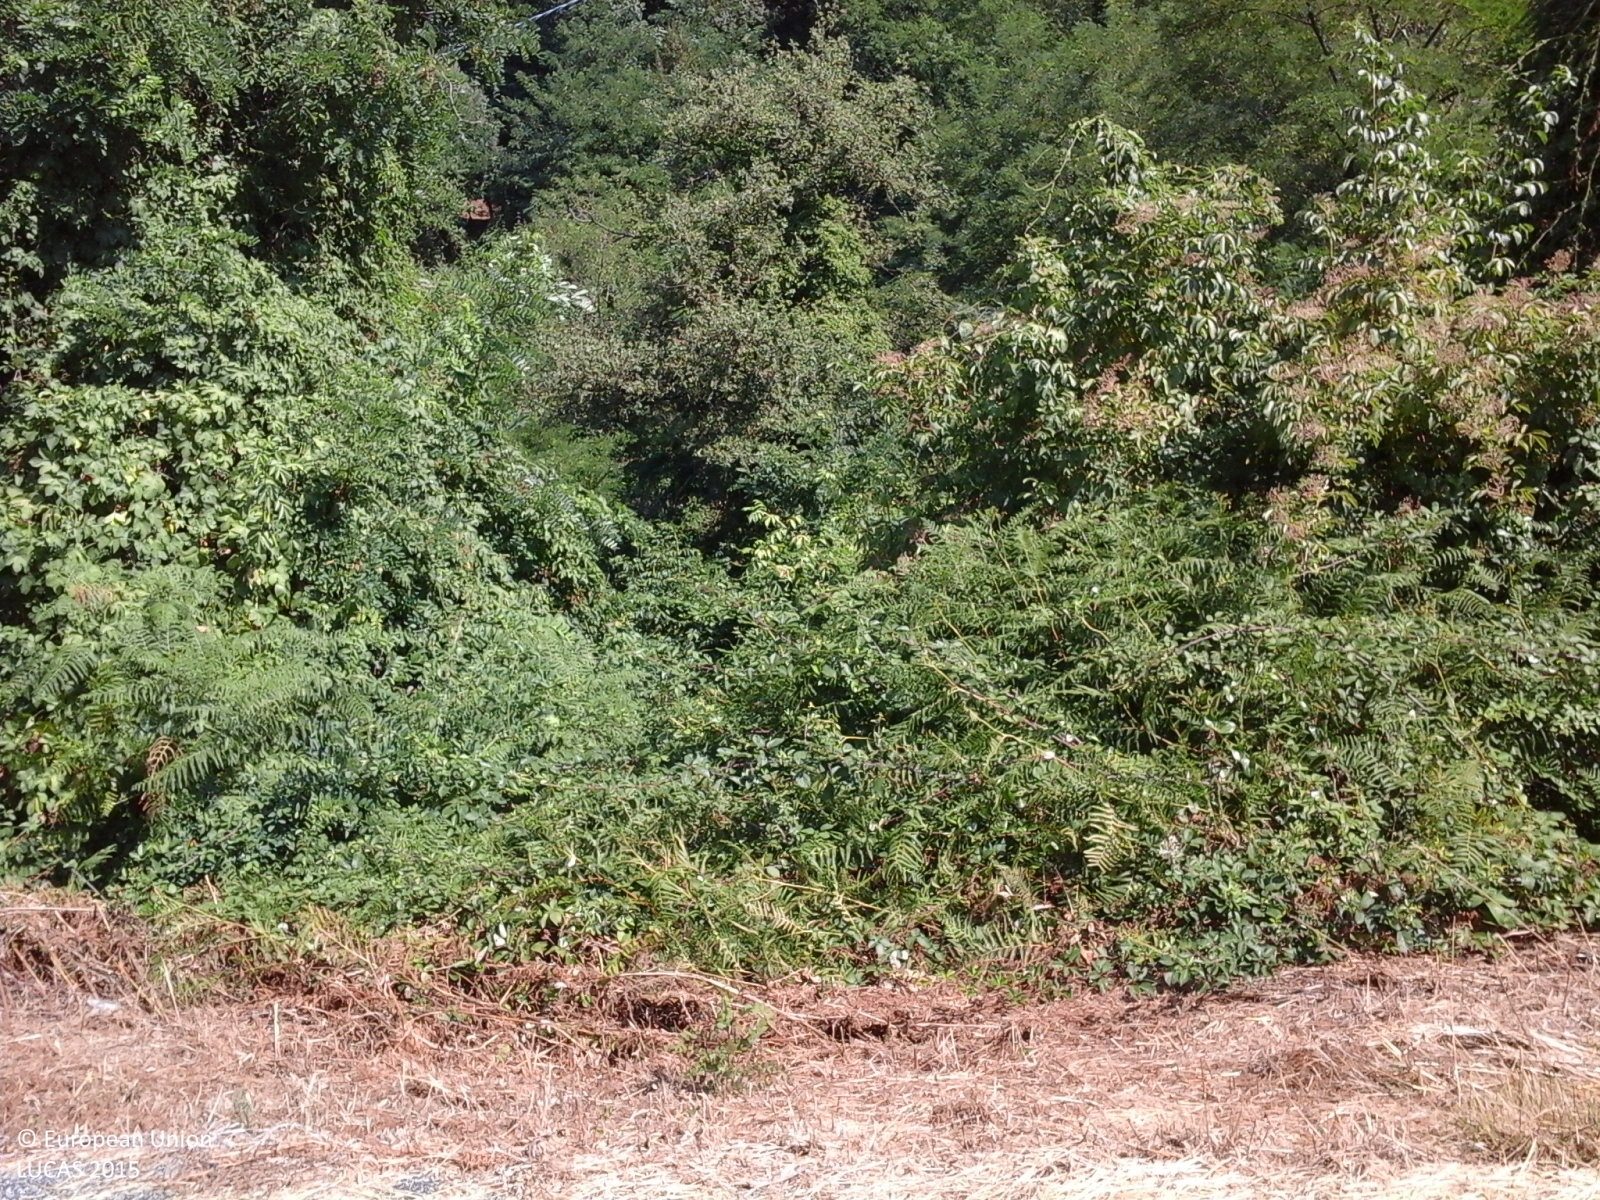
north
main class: Cropland
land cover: Olive groves
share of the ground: 25 - 50 %
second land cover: Grassland without tree/shrub cover
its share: 50 - 75 %
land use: Agriculture (excluding fallow land and kitchen gardens)
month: July
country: IT
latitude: 44.1882
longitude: 9.8877
